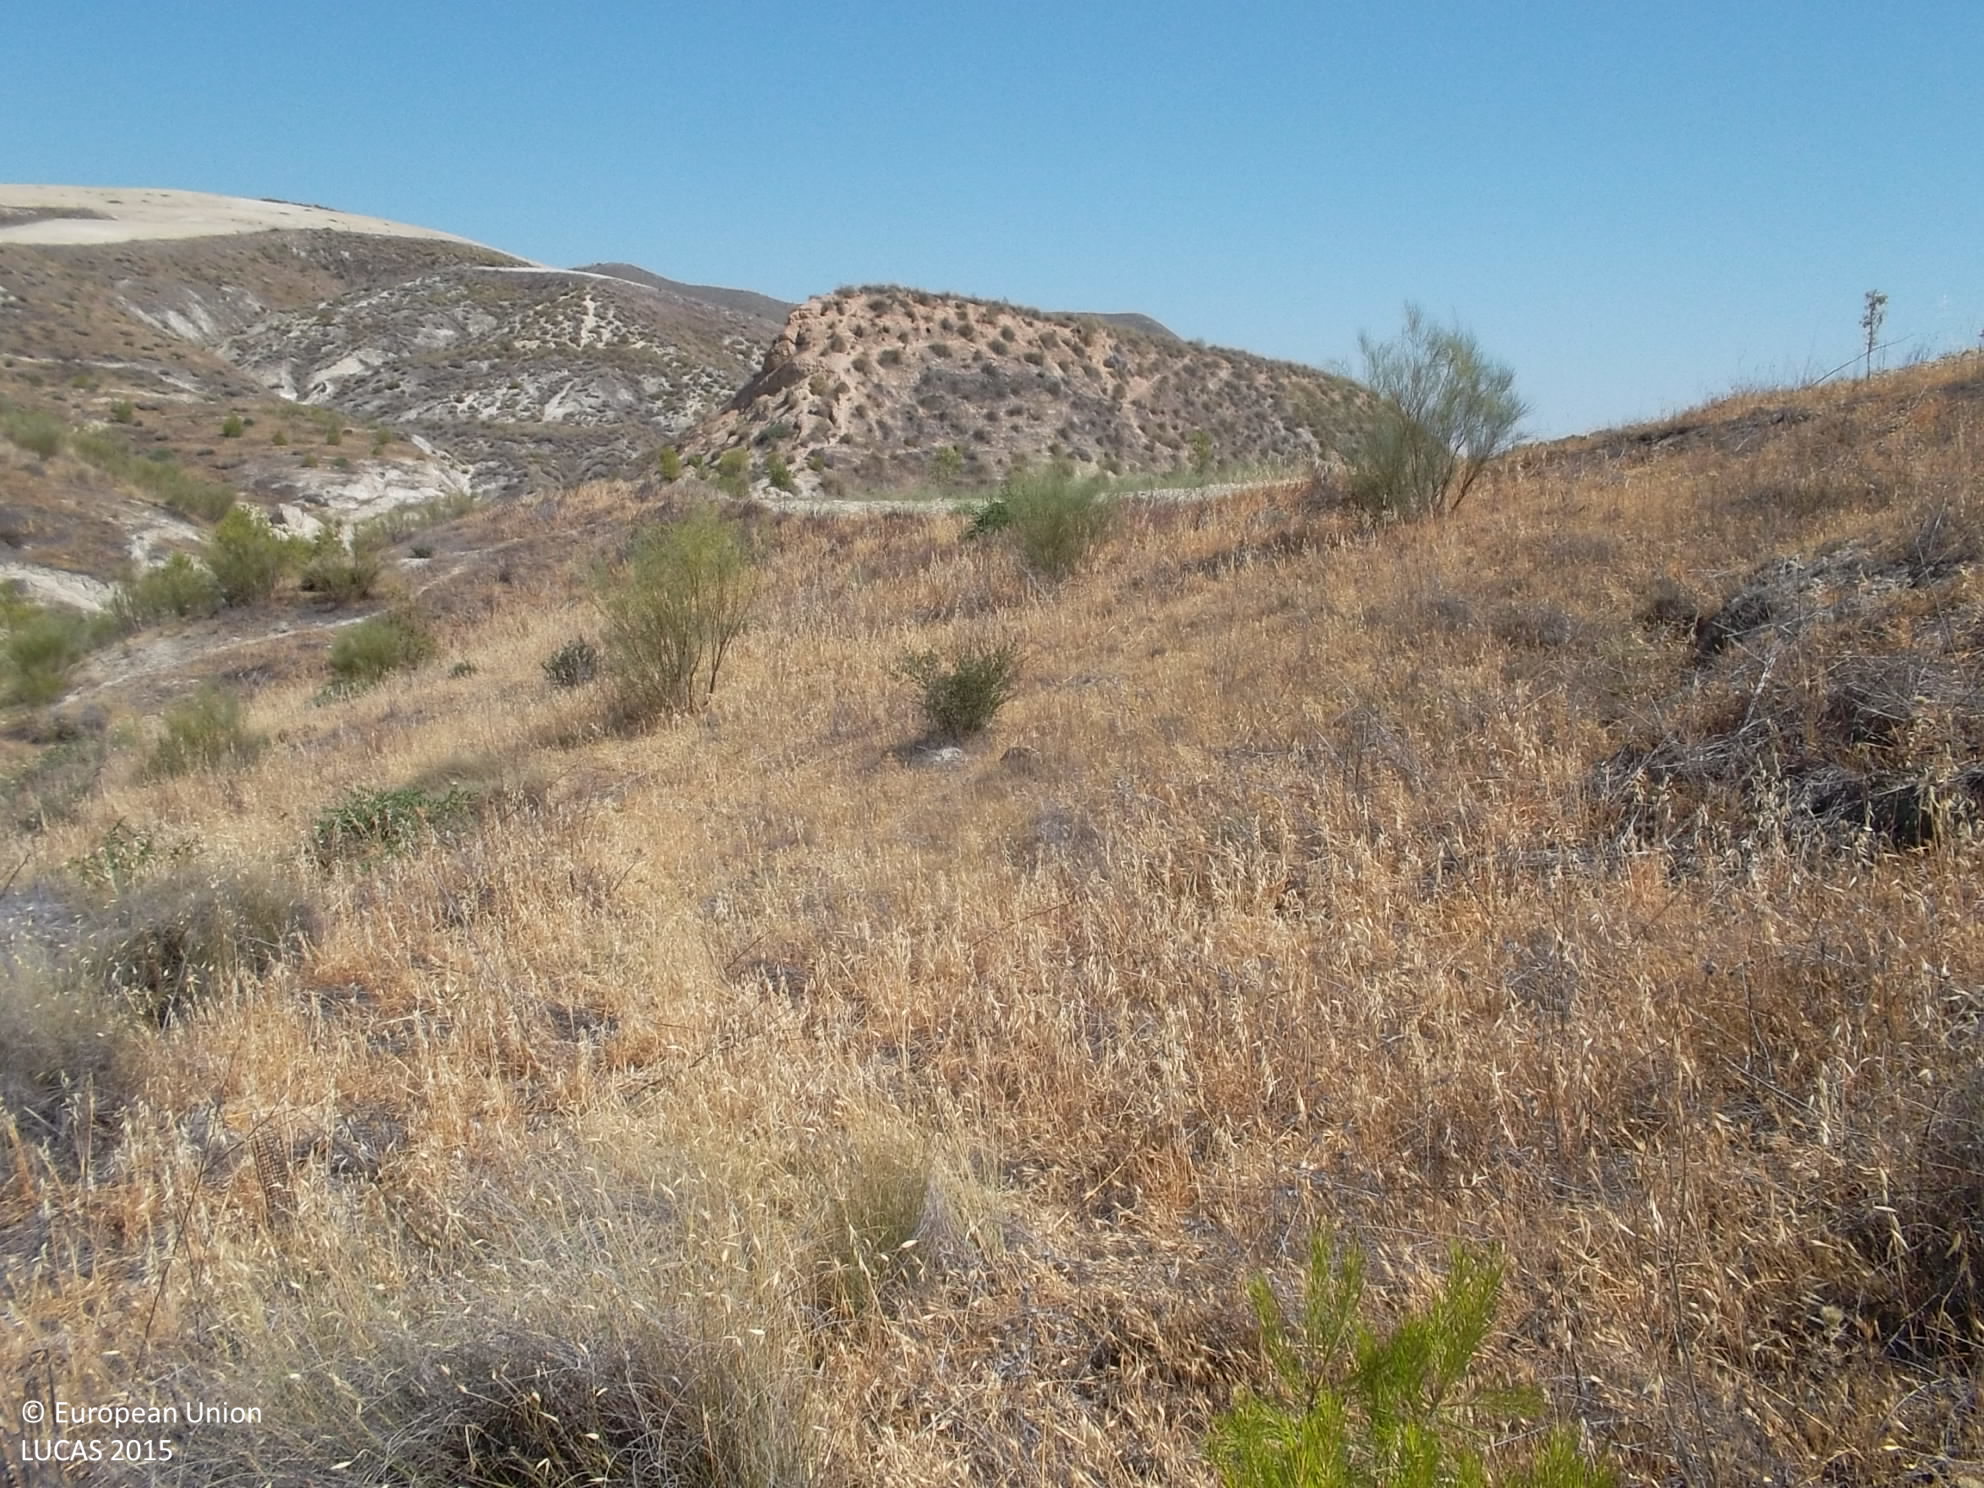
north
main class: Grassland
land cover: Grassland with sparse tree/shrub cover
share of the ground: 50 - 75 %
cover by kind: herbaceous plants 85 %, shrubs 10 %, broadleaved forest trees 5 %
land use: Semi-natural and natural areas not in use
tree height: < 5 m
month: June
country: ES
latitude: 37.8306
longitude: -3.2096
